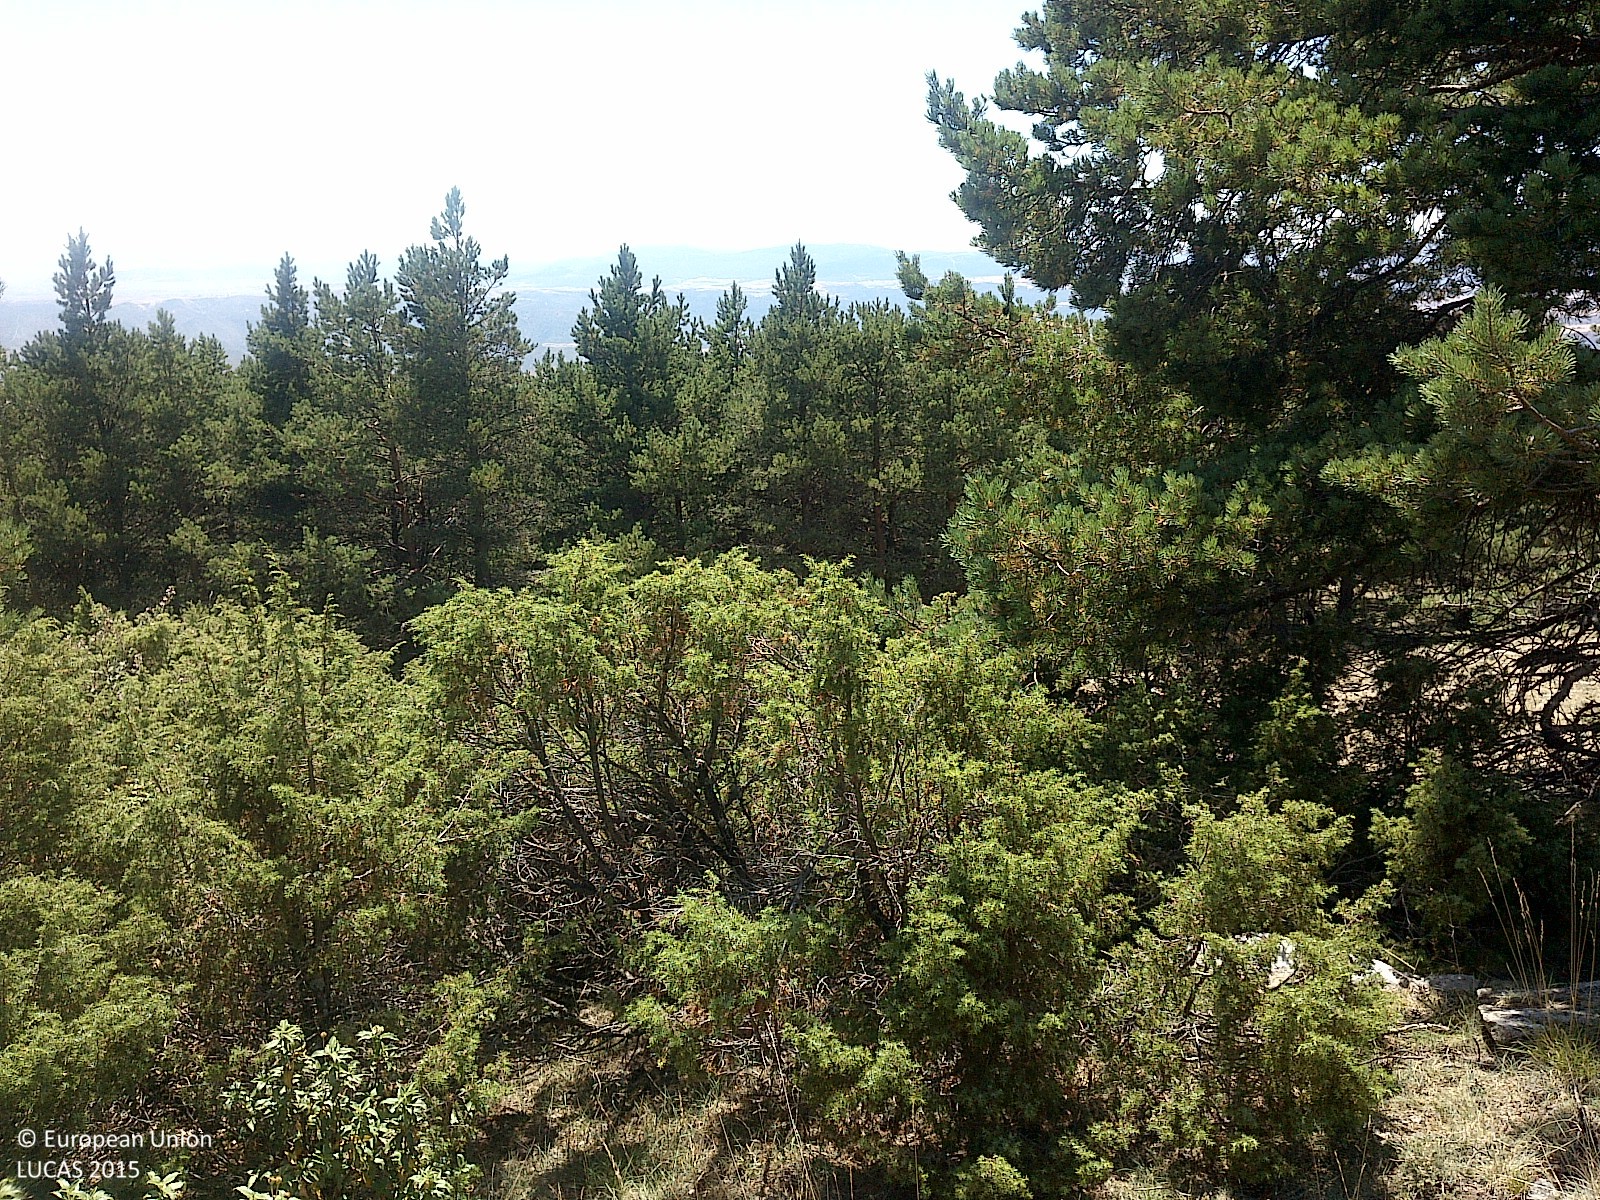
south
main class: Woodland
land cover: Pine dominated coniferous woodland
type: coniferous forest of the mediterranean region
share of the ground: 10 - 25 %
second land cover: Grassland without tree/shrub cover
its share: 25 - 50 %
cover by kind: herbaceous plants 40 %, shrubs 25 %, coniferous forest trees 20 %, unconsolidated bare surface 10 %, consolidated bare surface 5 %
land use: Forestry
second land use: Agriculture (excluding fallow land and kitchen gardens)
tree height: < 5 m
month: July
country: ES
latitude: 41.9962
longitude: -2.1206
